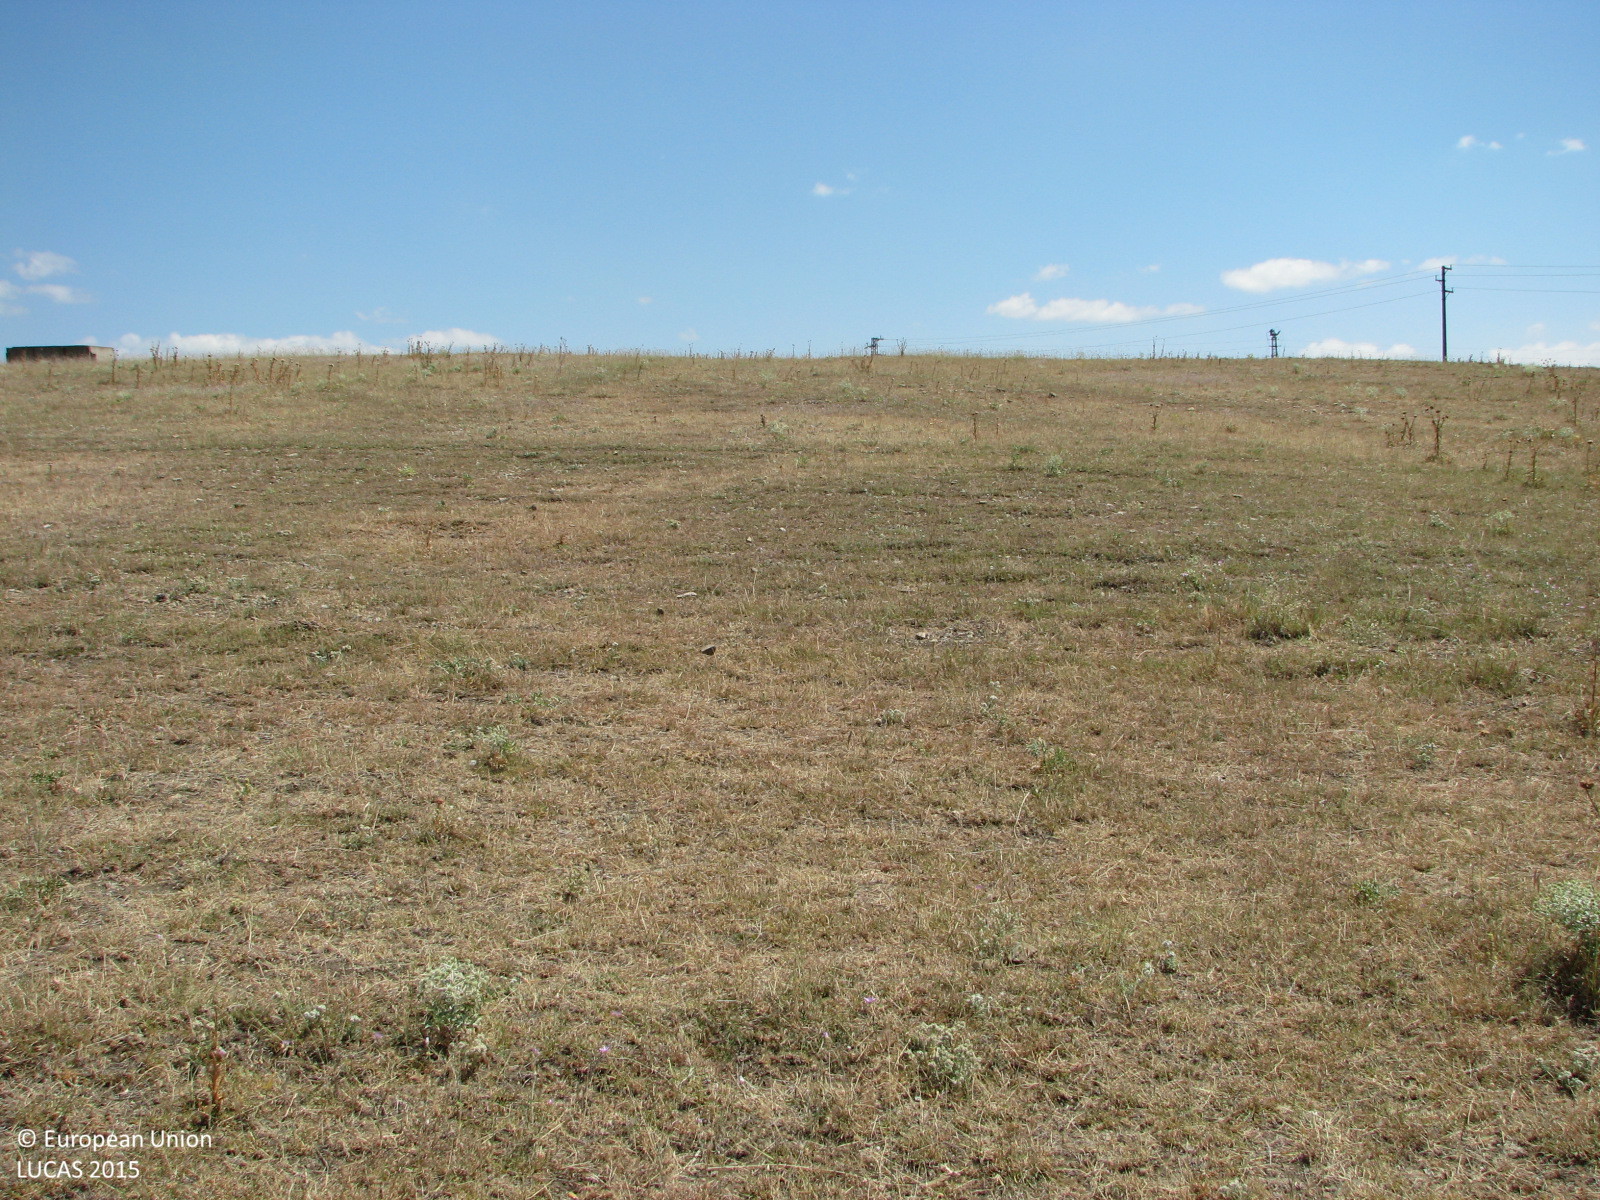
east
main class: Grassland
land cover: Grassland without tree/shrub cover
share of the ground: > 75 %
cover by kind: herbaceous plants 90 %, unconsolidated bare surface 10 %
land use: Semi-natural and natural areas not in use
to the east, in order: Grassland without tree/shrub cover; Tracks; Grassland without tree/shrub cover; Dry stone walls; Grassland without tree/shrub cover; Ditches and canals; Grassland without tree/shrub cover; Electric lines; Grassland without tree/shrub cover
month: July
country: BG
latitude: 42.6099
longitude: 26.4139
